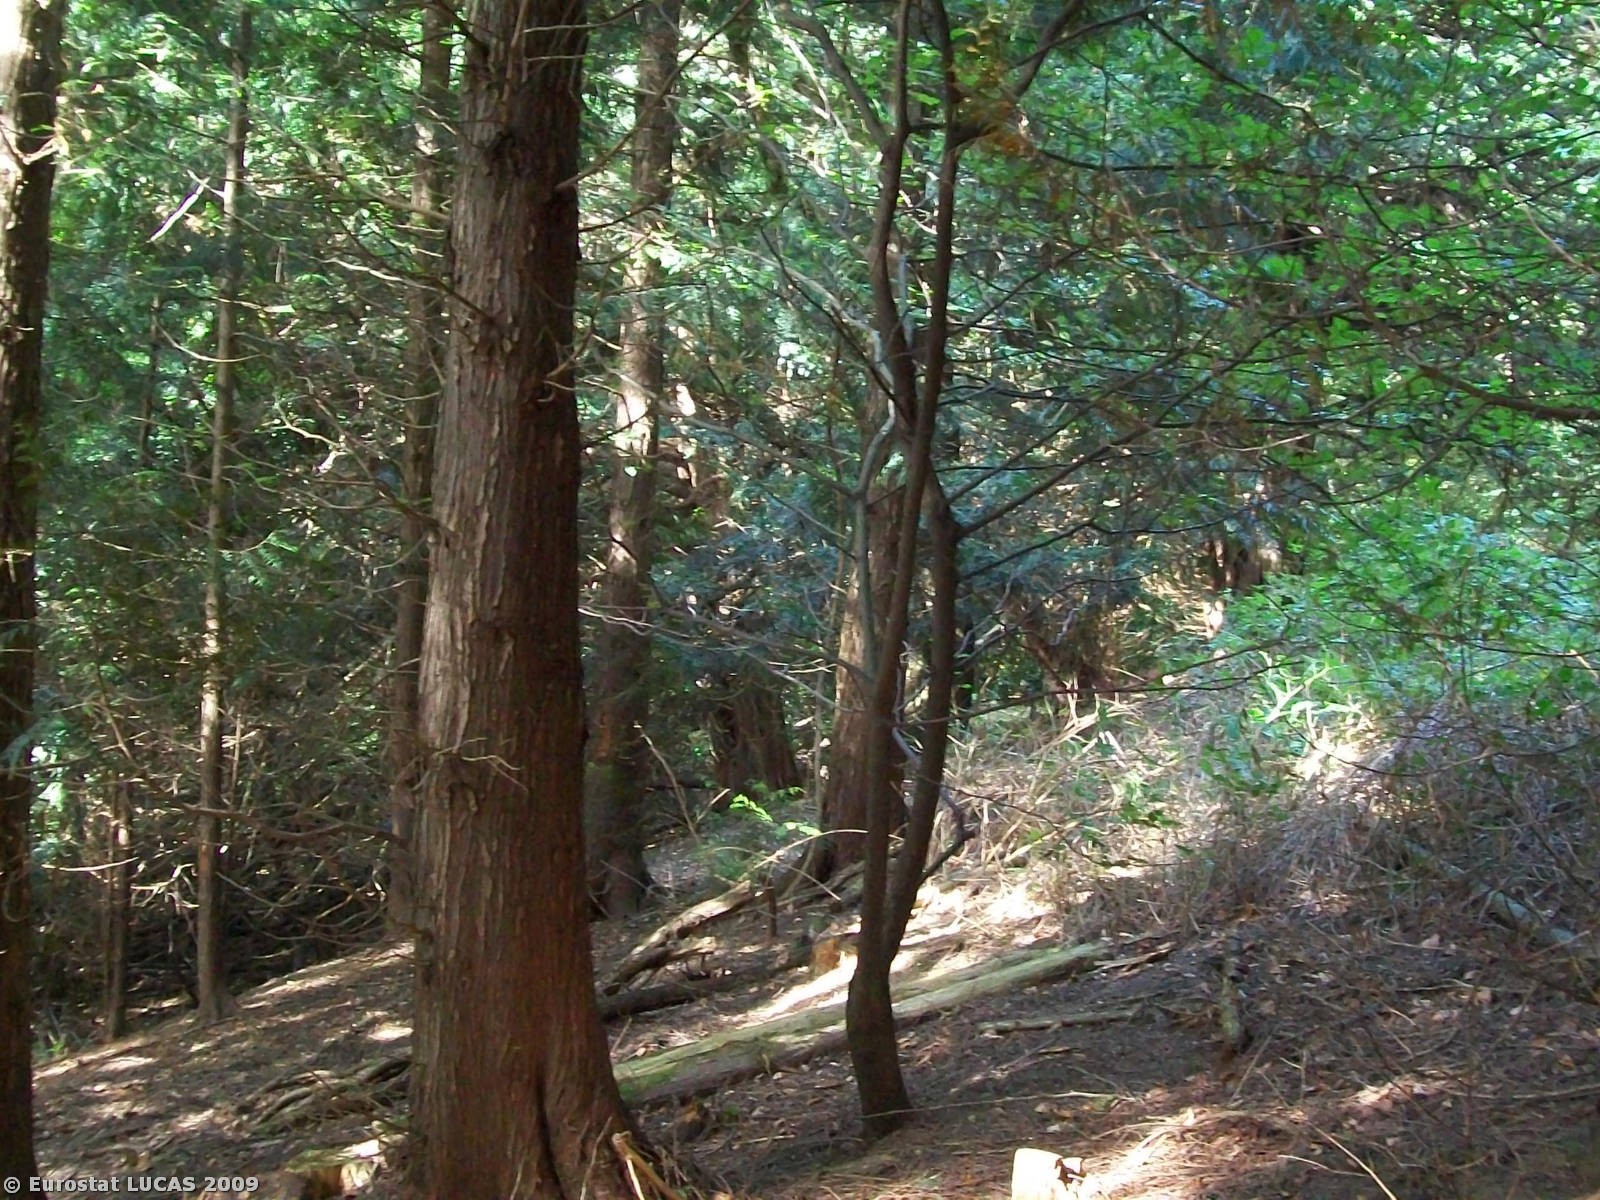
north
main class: Woodland
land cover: Coniferous woodland
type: plantations and self-sown exotic forest
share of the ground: > 75 %
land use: Community services
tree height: > 5 m
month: September
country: GB
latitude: 52.0324
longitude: -2.4112
